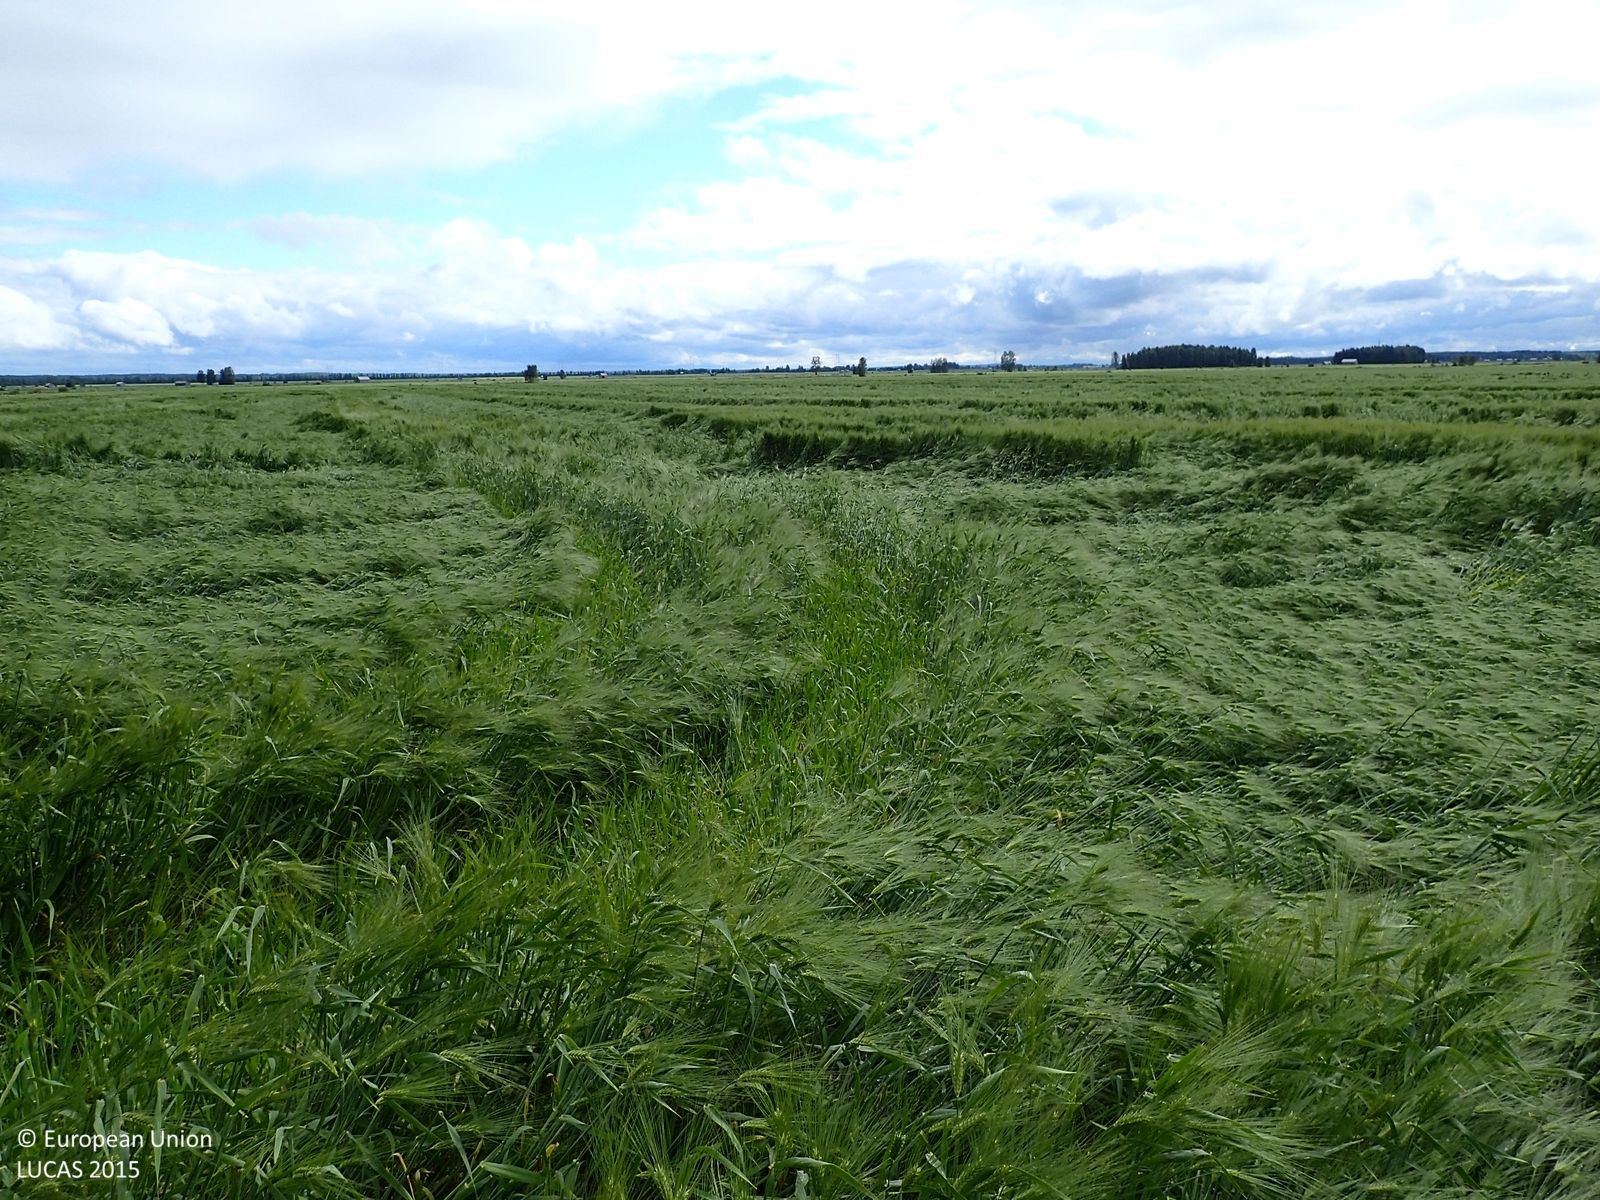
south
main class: Cropland
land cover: Oats
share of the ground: > 75 %
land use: Agriculture (excluding fallow land and kitchen gardens)
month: July
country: FI
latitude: 62.8248
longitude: 22.6751
